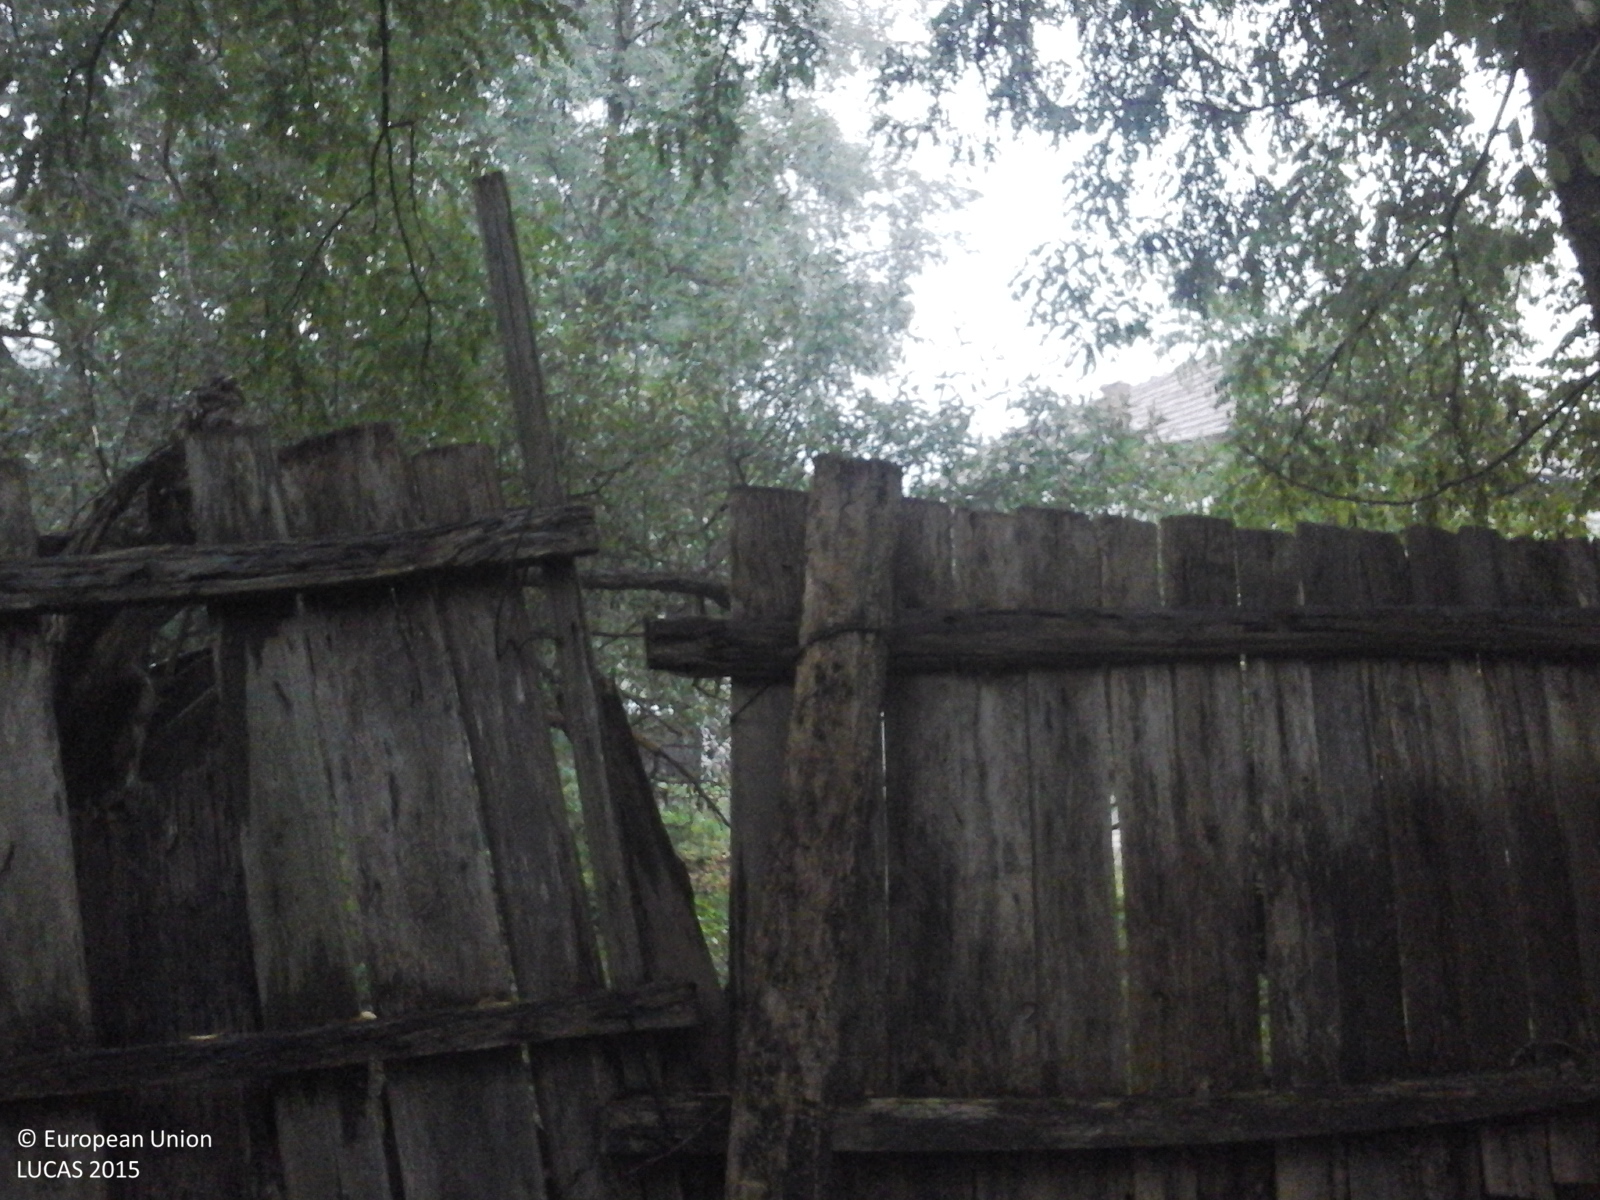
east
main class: Woodland
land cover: Broadleaved woodland
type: exotic forest
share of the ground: > 75 %
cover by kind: broadleaved forest trees 100 %
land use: Forestry
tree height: > 5 m
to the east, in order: Broadleaved woodland; Artificial constructions in urban areas; Broadleaved woodland
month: September
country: RO
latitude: 44.9271
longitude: 22.9072
